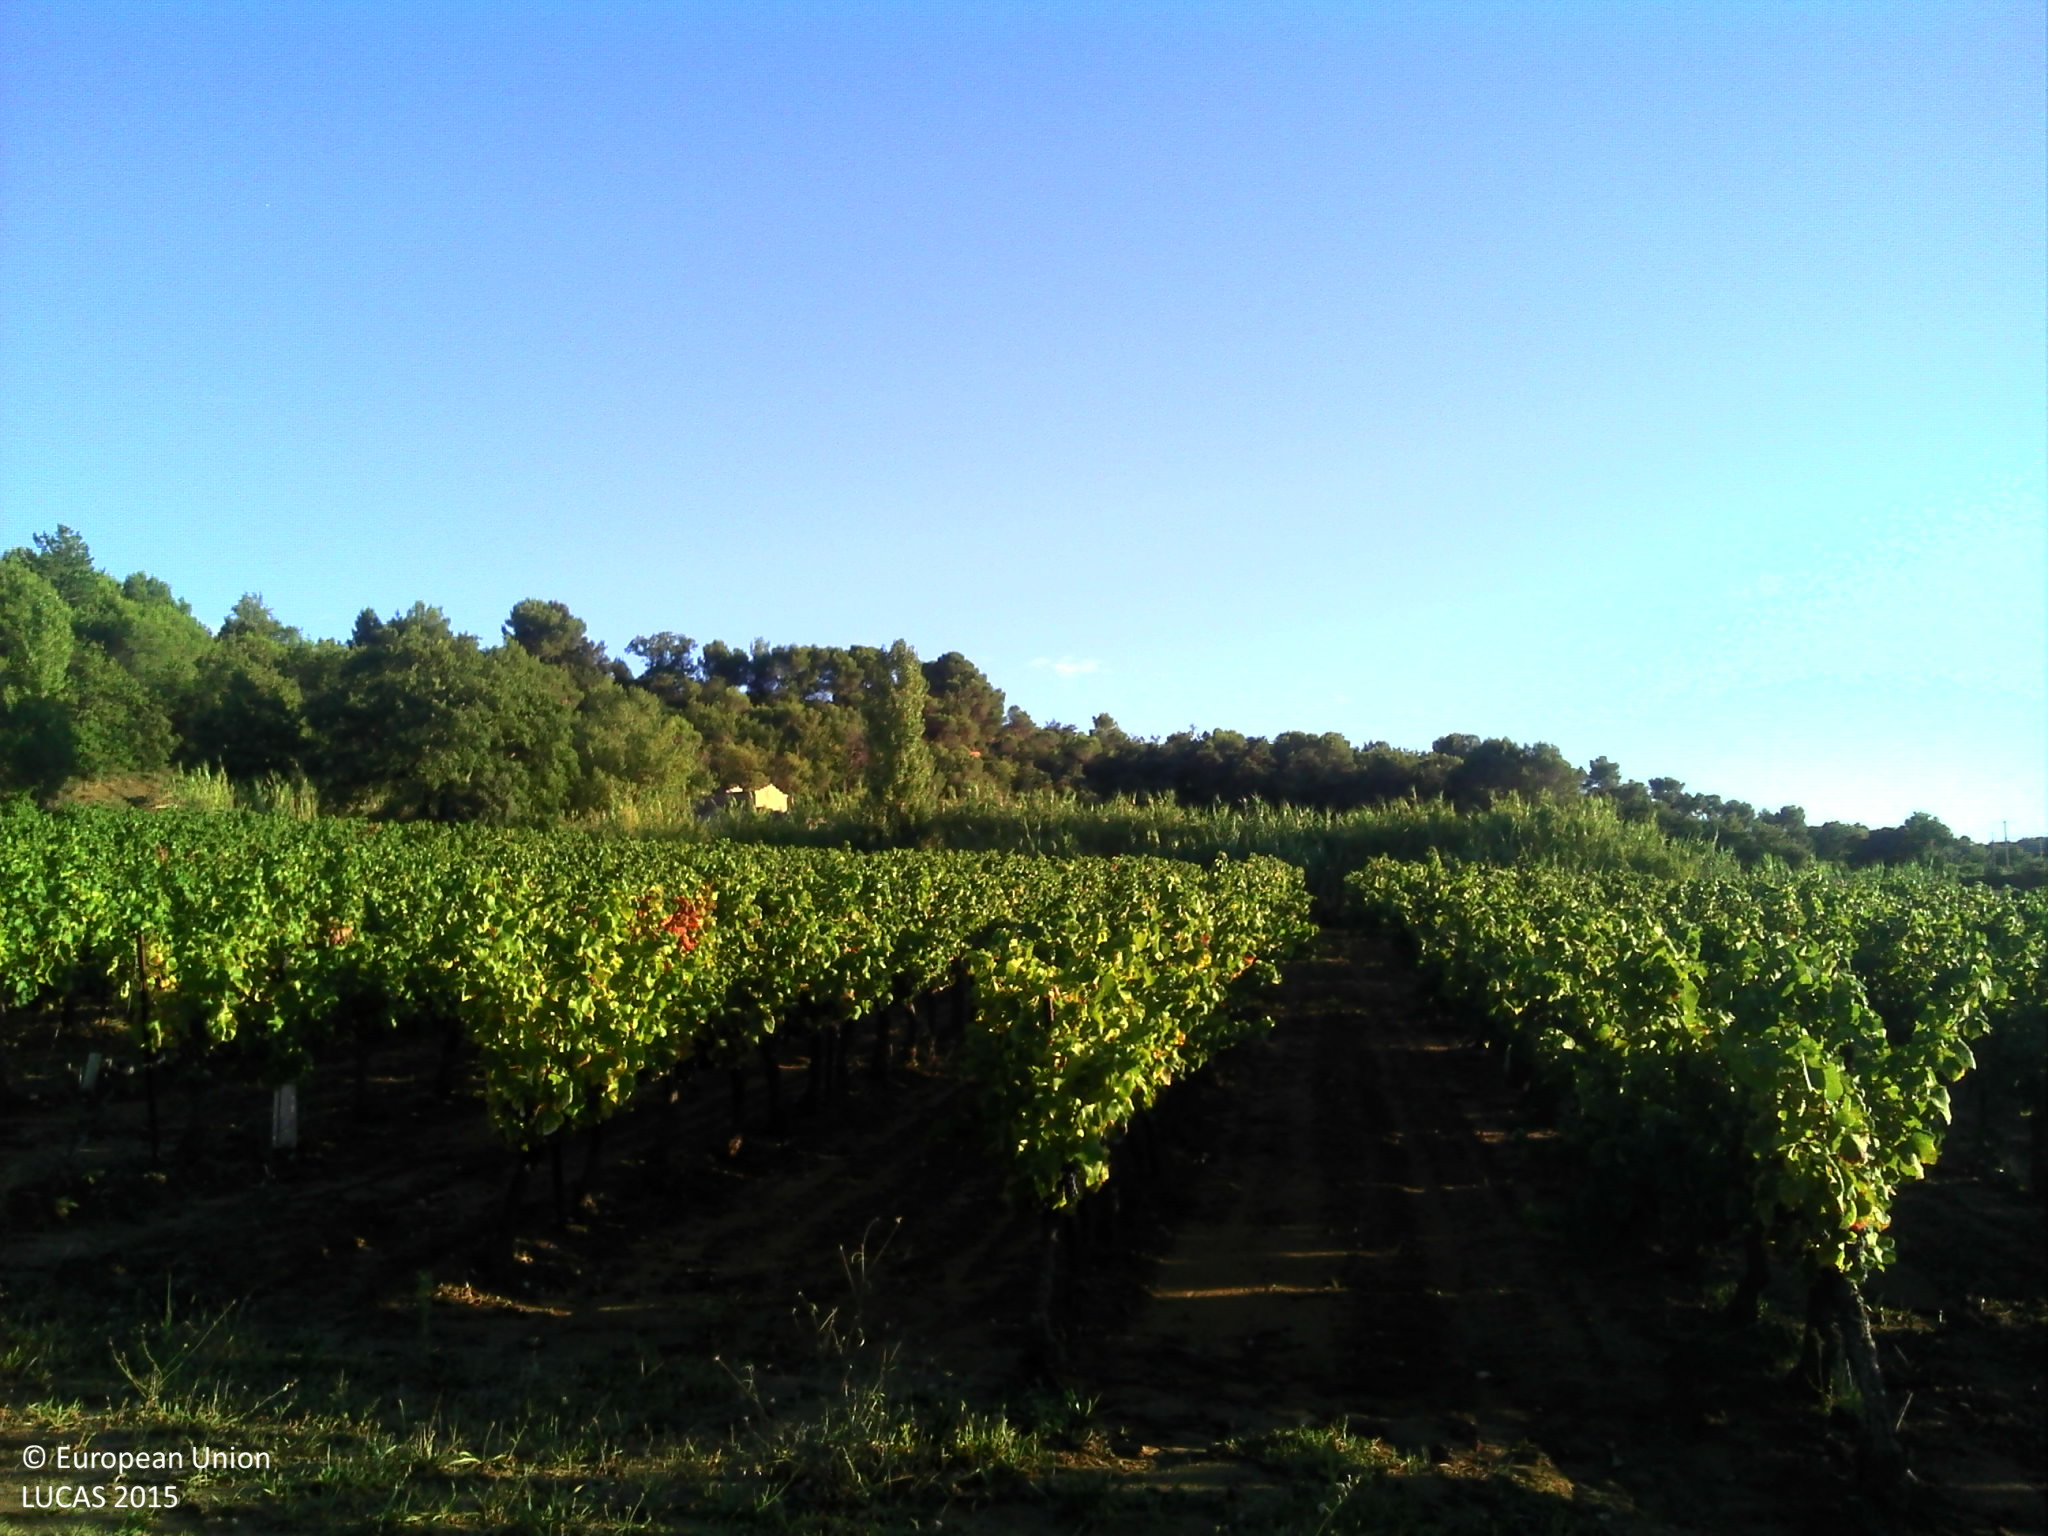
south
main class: Cropland
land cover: Vineyards
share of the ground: 10 - 25 %
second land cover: Other bare soil
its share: > 75 %
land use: Agriculture (excluding fallow land and kitchen gardens)
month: September
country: FR
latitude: 44.2894
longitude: 5.1076
